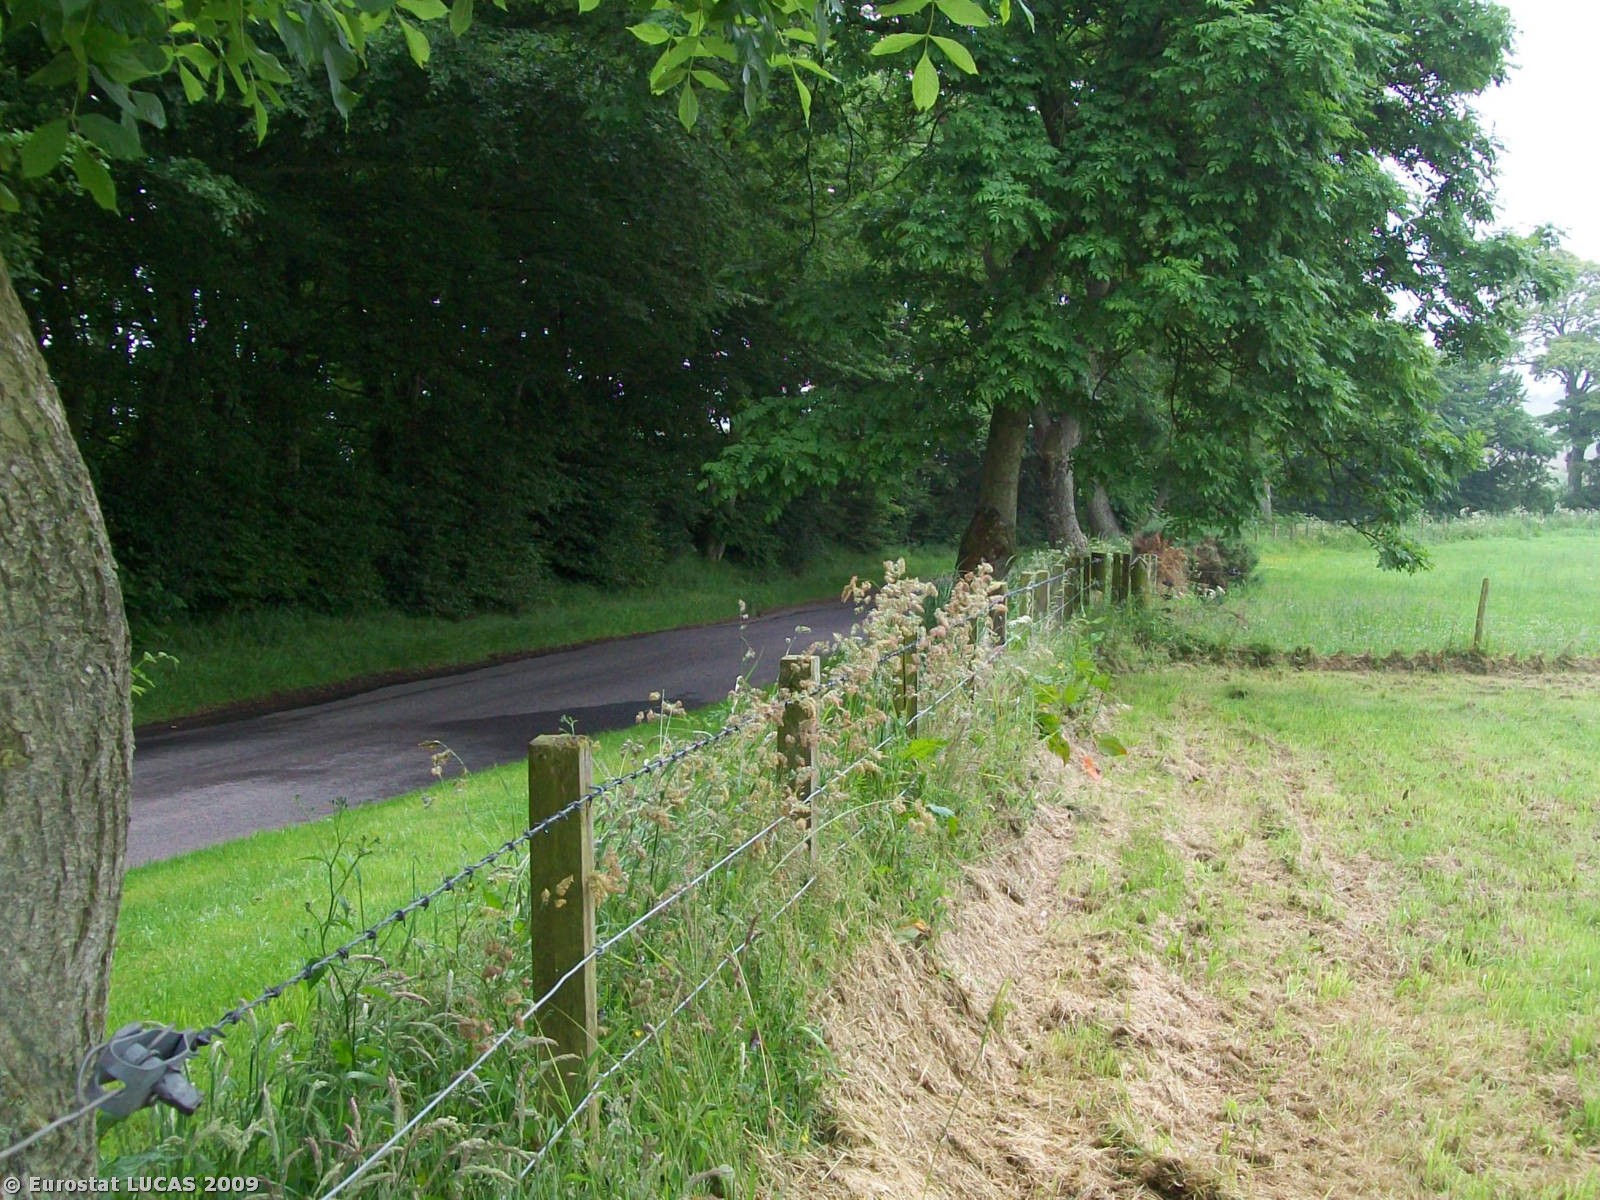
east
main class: Grassland
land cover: Grassland without tree/shrub cover
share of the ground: > 75 %
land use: Agriculture (excluding fallow land and kitchen gardens)
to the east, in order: Grassland without tree/shrub cover; Fences; Single bushes/trees; Grass margins; Paved roads, cycling and walking lanes; Grass margins; Broadleaved woodland; Grass margins; Abandoned hedges; Grass margins; Tracks; Grass margins; Abandoned hedges; Grass margins; Barley
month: June
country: GB
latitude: 56.6568
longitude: -2.6028
